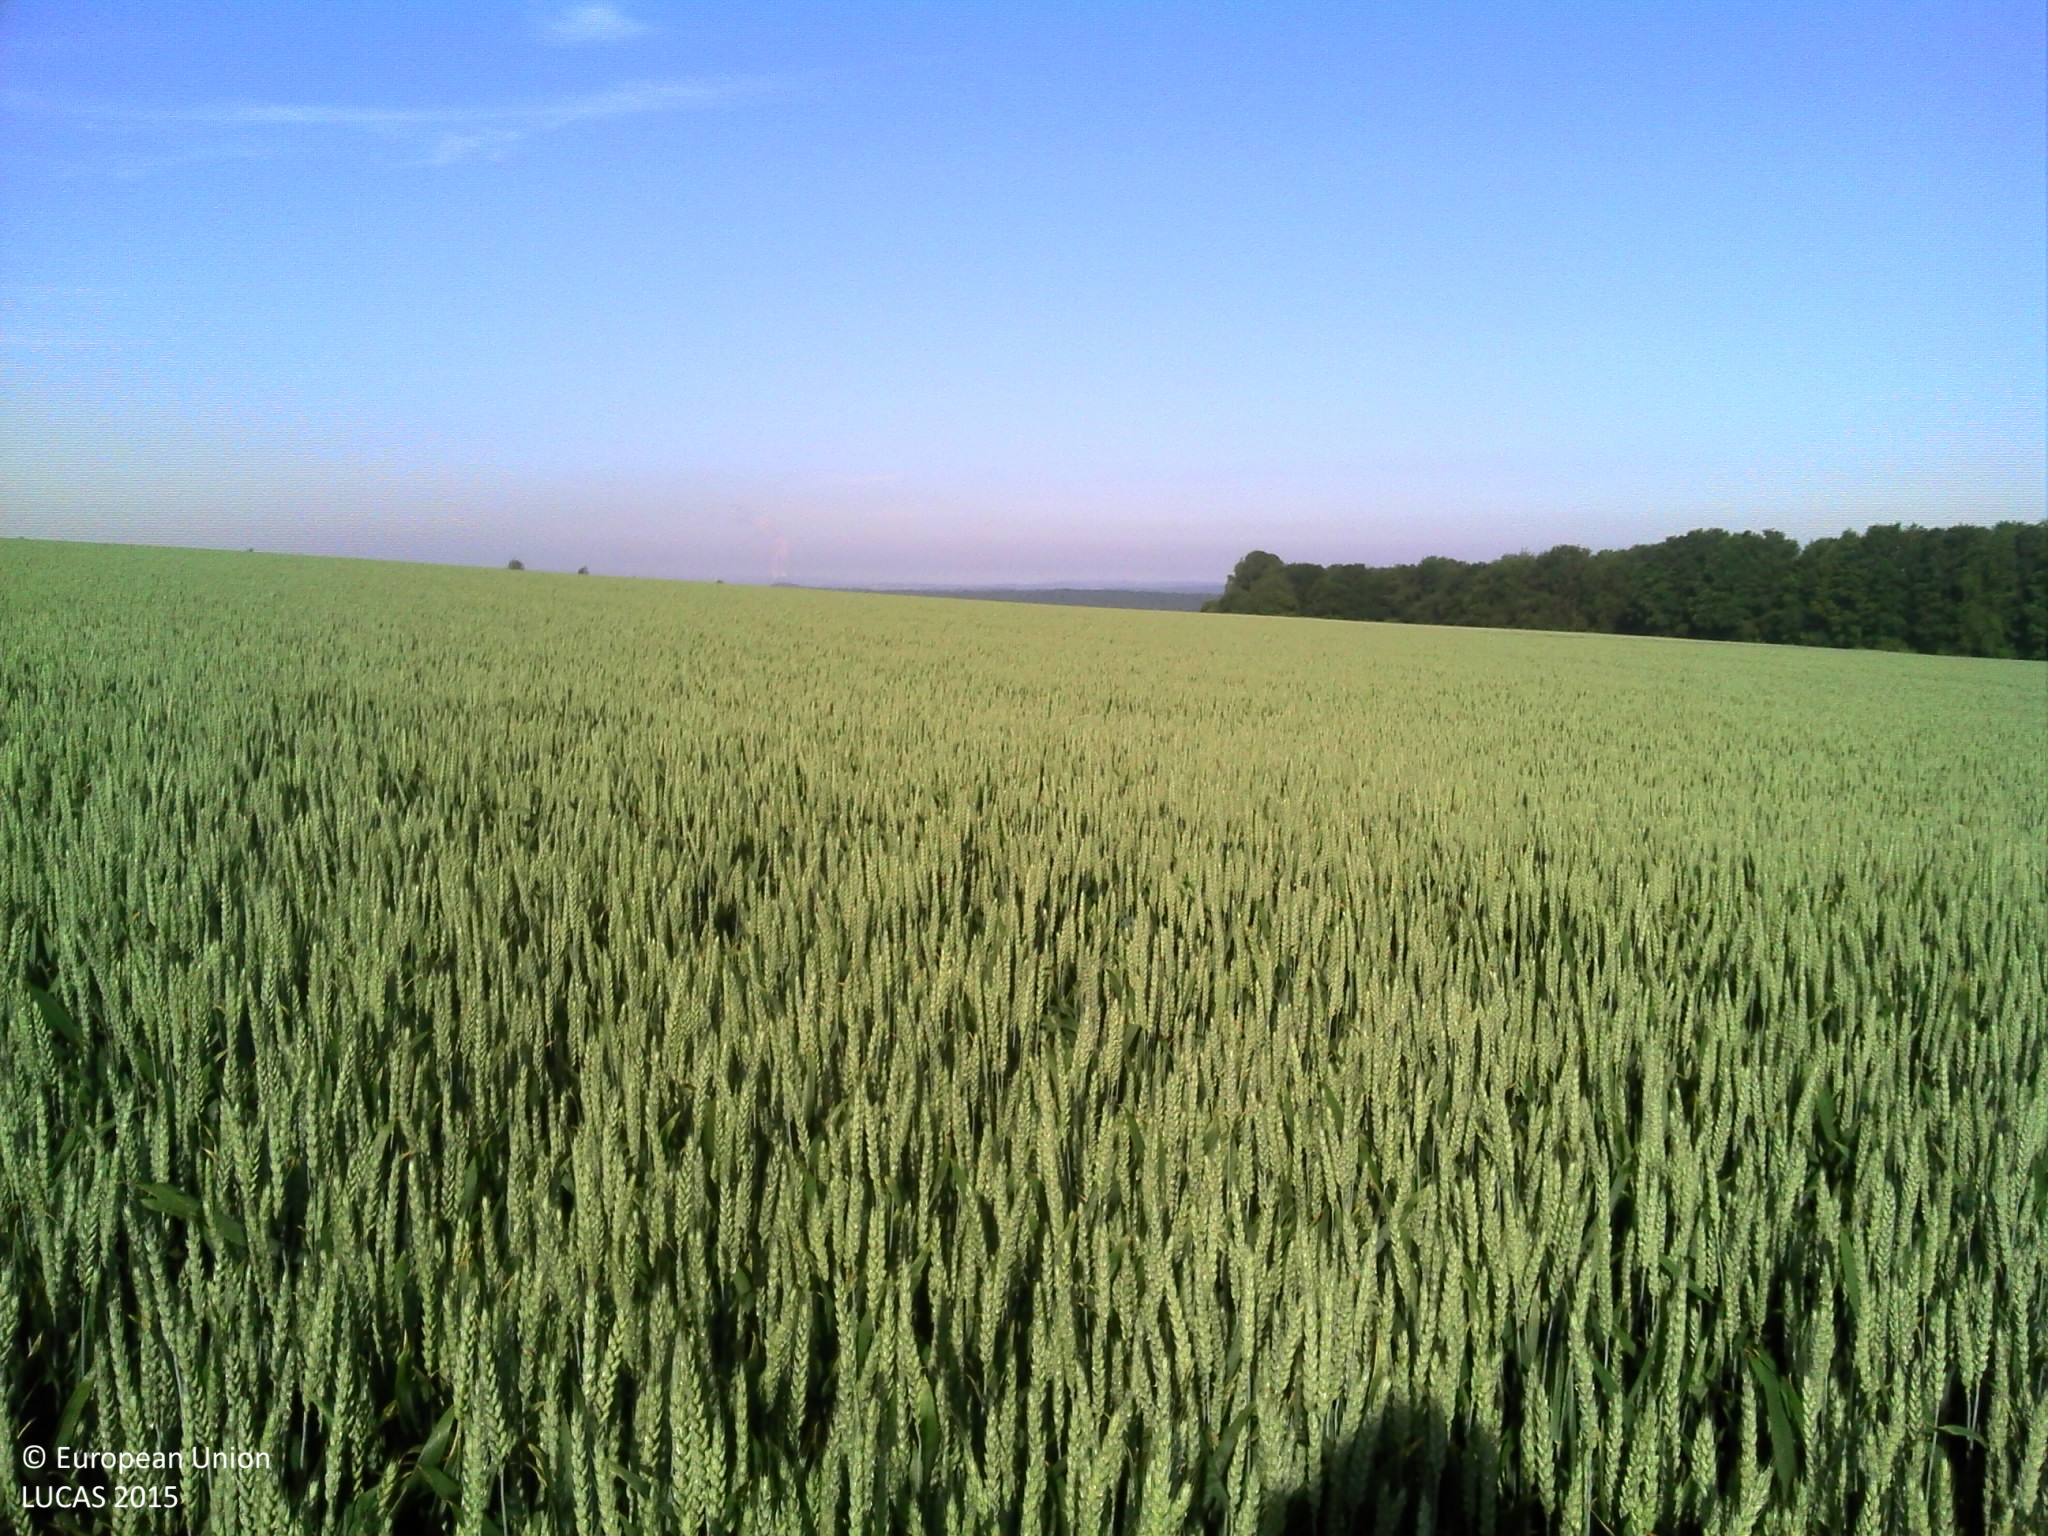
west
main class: Cropland
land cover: Common wheat
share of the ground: > 75 %
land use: Agriculture (excluding fallow land and kitchen gardens)
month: June
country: BE
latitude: 50.1934
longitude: 5.2492
